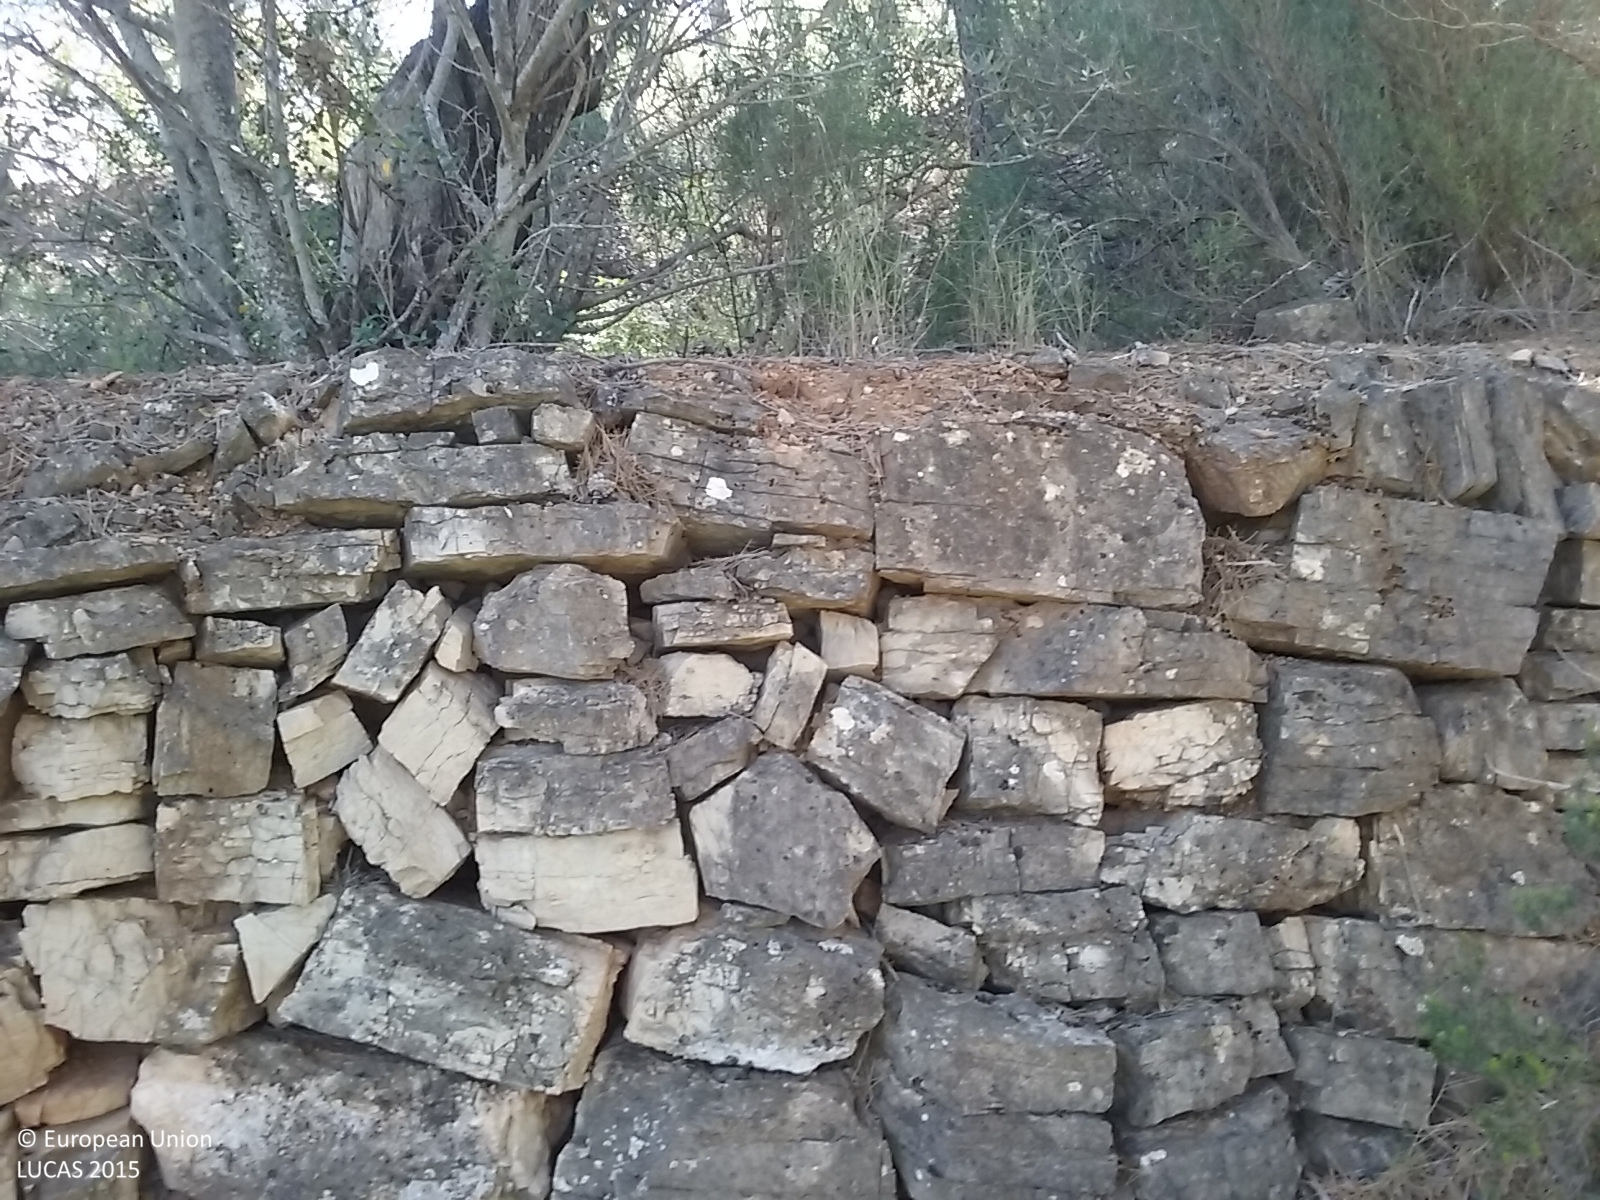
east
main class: Woodland
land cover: Pine dominated coniferous woodland
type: coniferous forest of the mediterranean region
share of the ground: 50 - 75 %
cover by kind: coniferous forest trees 55 %, herbaceous plants 25 %, shrubs 20 %
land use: Semi-natural and natural areas not in use
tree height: > 5 m
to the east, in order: Pine dominated coniferous woodland; Dry stone walls; Olive groves; Dry stone walls; Pine dominated coniferous woodland; Dry stone walls; Pine dominated coniferous woodland; Dry stone walls; Pine dominated coniferous woodland; Dry stone walls; Pine dominated coniferous woodland; Dry stone walls; Pine dominated coniferous woodland; Tracks; Dry stone walls; Olive groves; Dry stone walls; Olive groves; Dry stone walls; Olive groves; Dry stone walls; Olive groves; Dry stone walls; Olive groves; Tracks; Olive groves; Dry stone walls; Olive groves; Pine dominated coniferous woodland; Dry stone walls
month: June
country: ES
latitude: 40.9902
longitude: 0.5186
